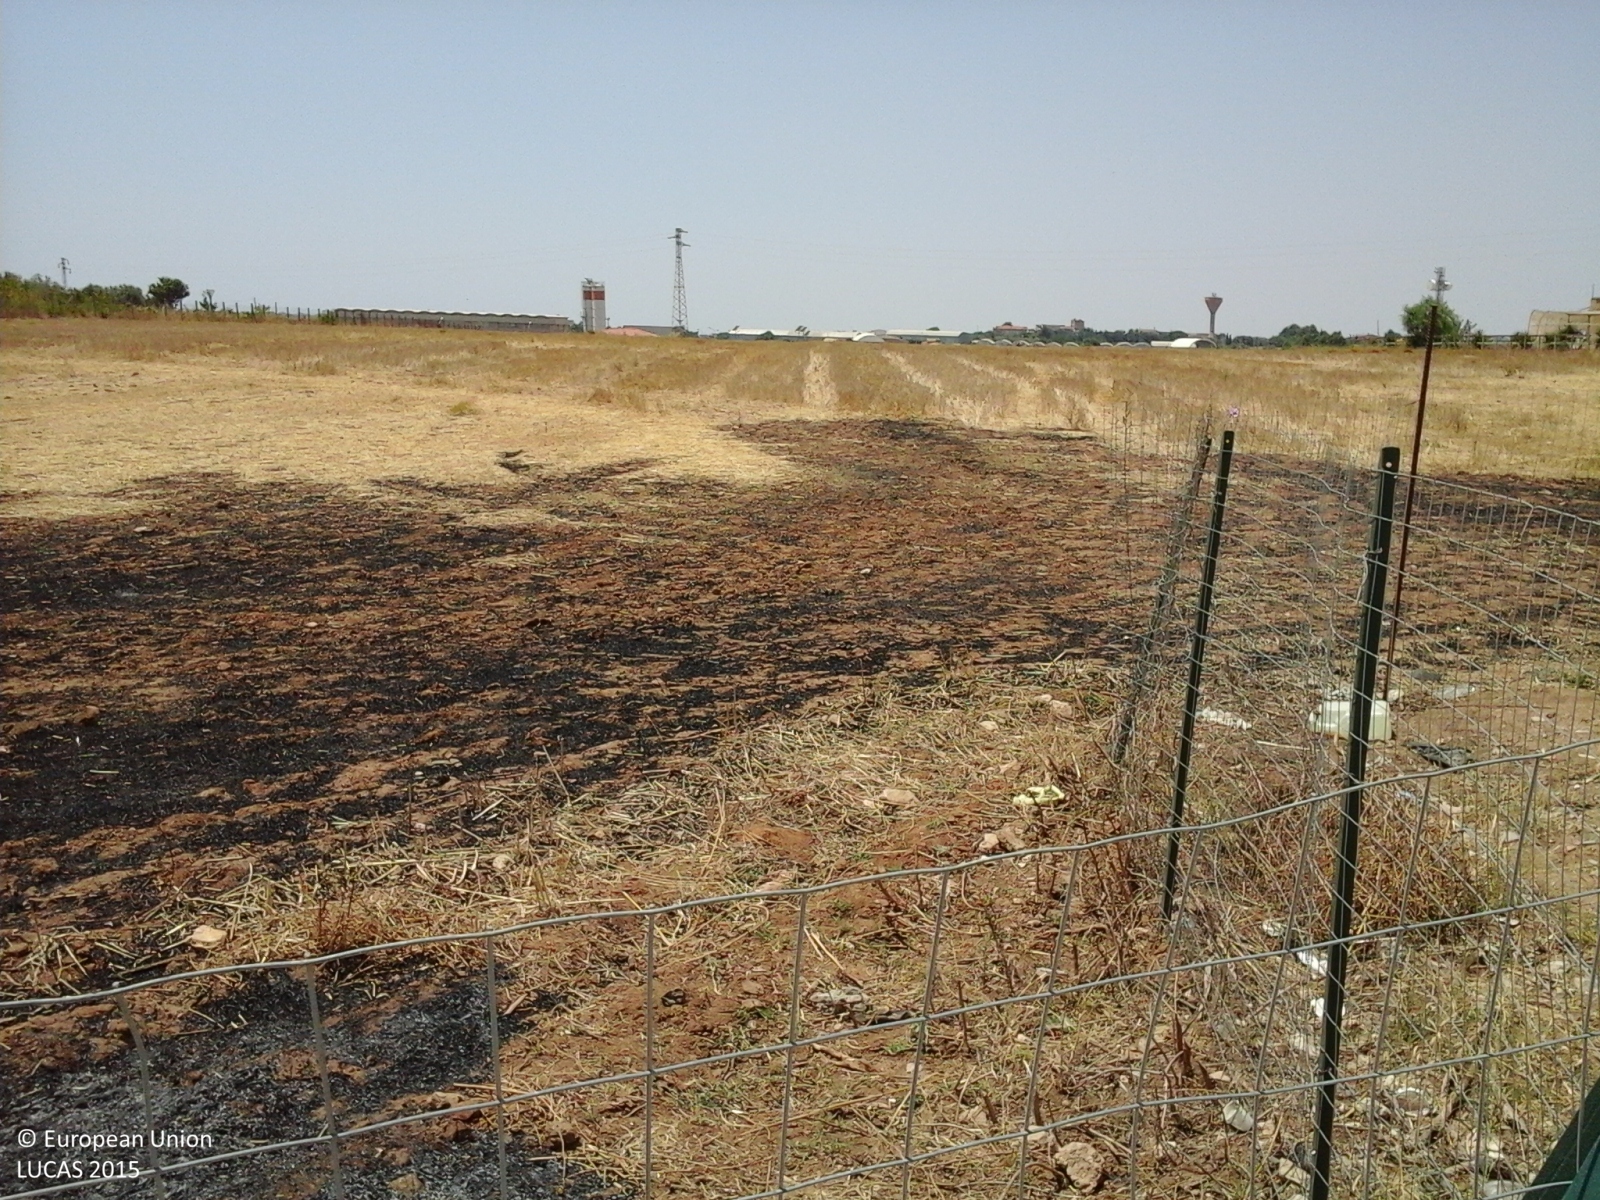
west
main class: Cropland
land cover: Durum wheat
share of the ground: > 75 %
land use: Agriculture (excluding fallow land and kitchen gardens)
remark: Burnt area
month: July
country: IT
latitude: 37.1541
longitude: 14.4133
